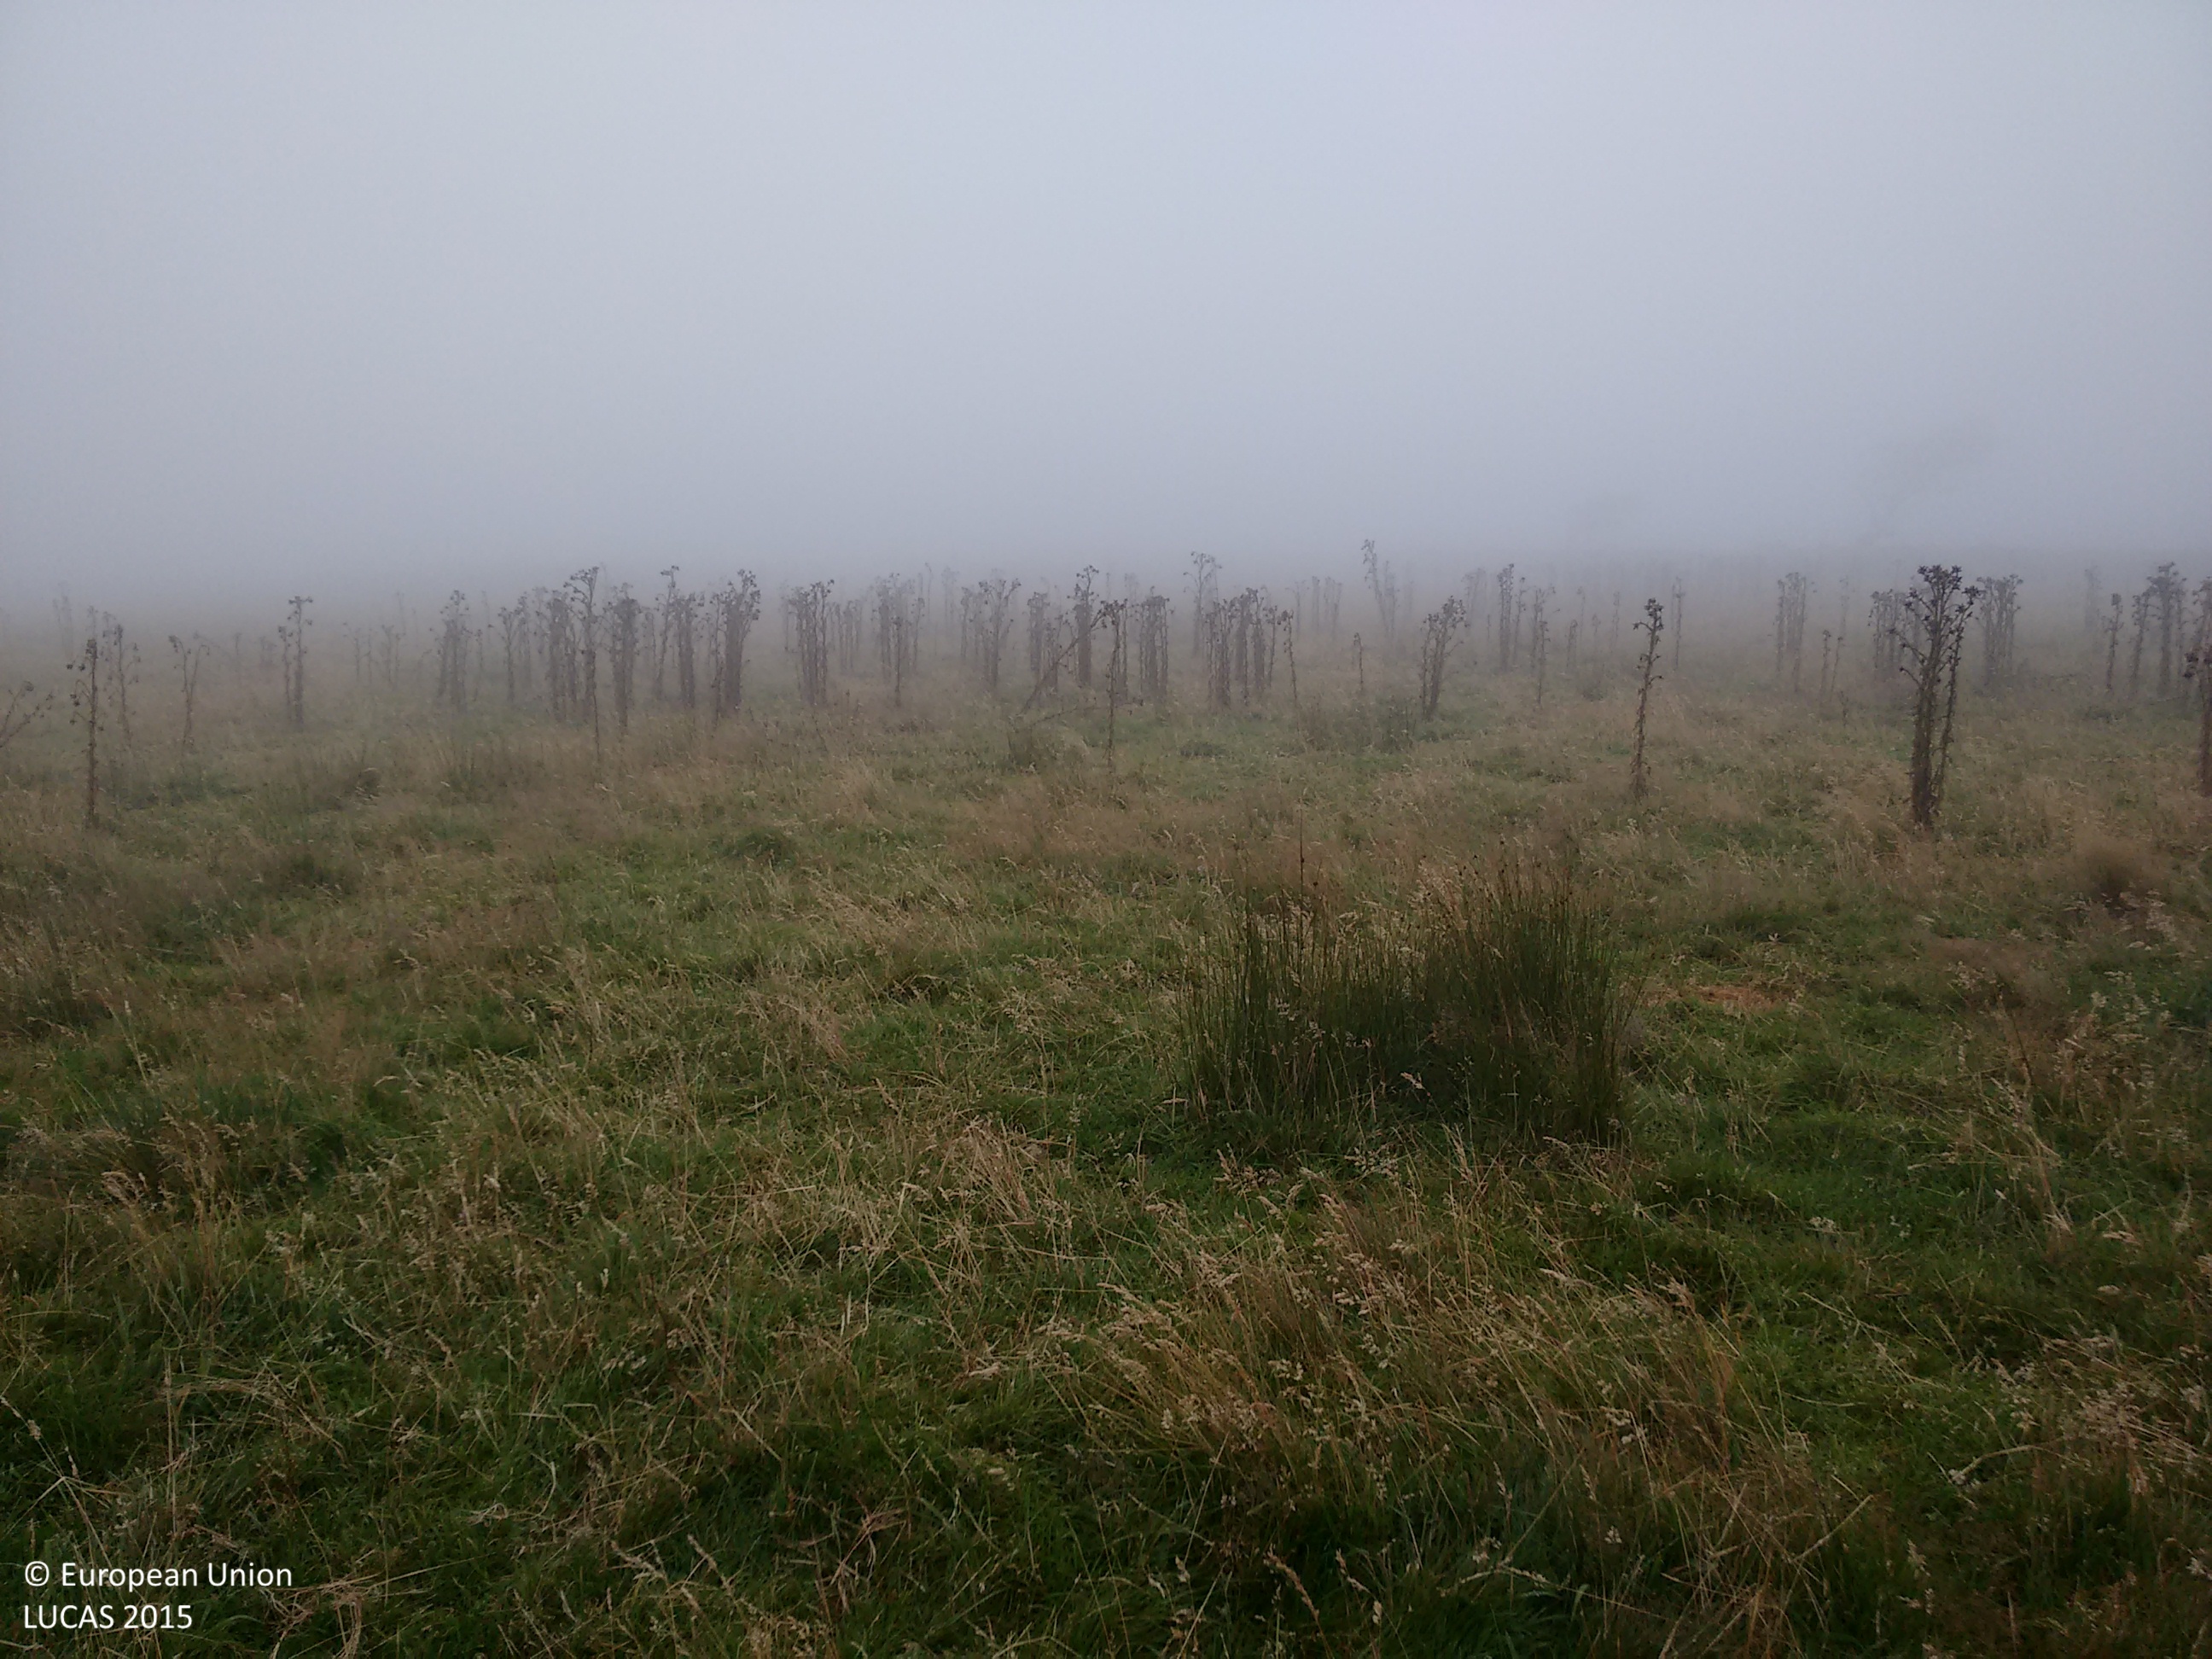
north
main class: Grassland
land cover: Grassland without tree/shrub cover
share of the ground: > 75 %
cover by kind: herbaceous plants 100 %
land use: Agriculture (excluding fallow land and kitchen gardens)
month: August
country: GB
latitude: 51.1257
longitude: -3.8219
